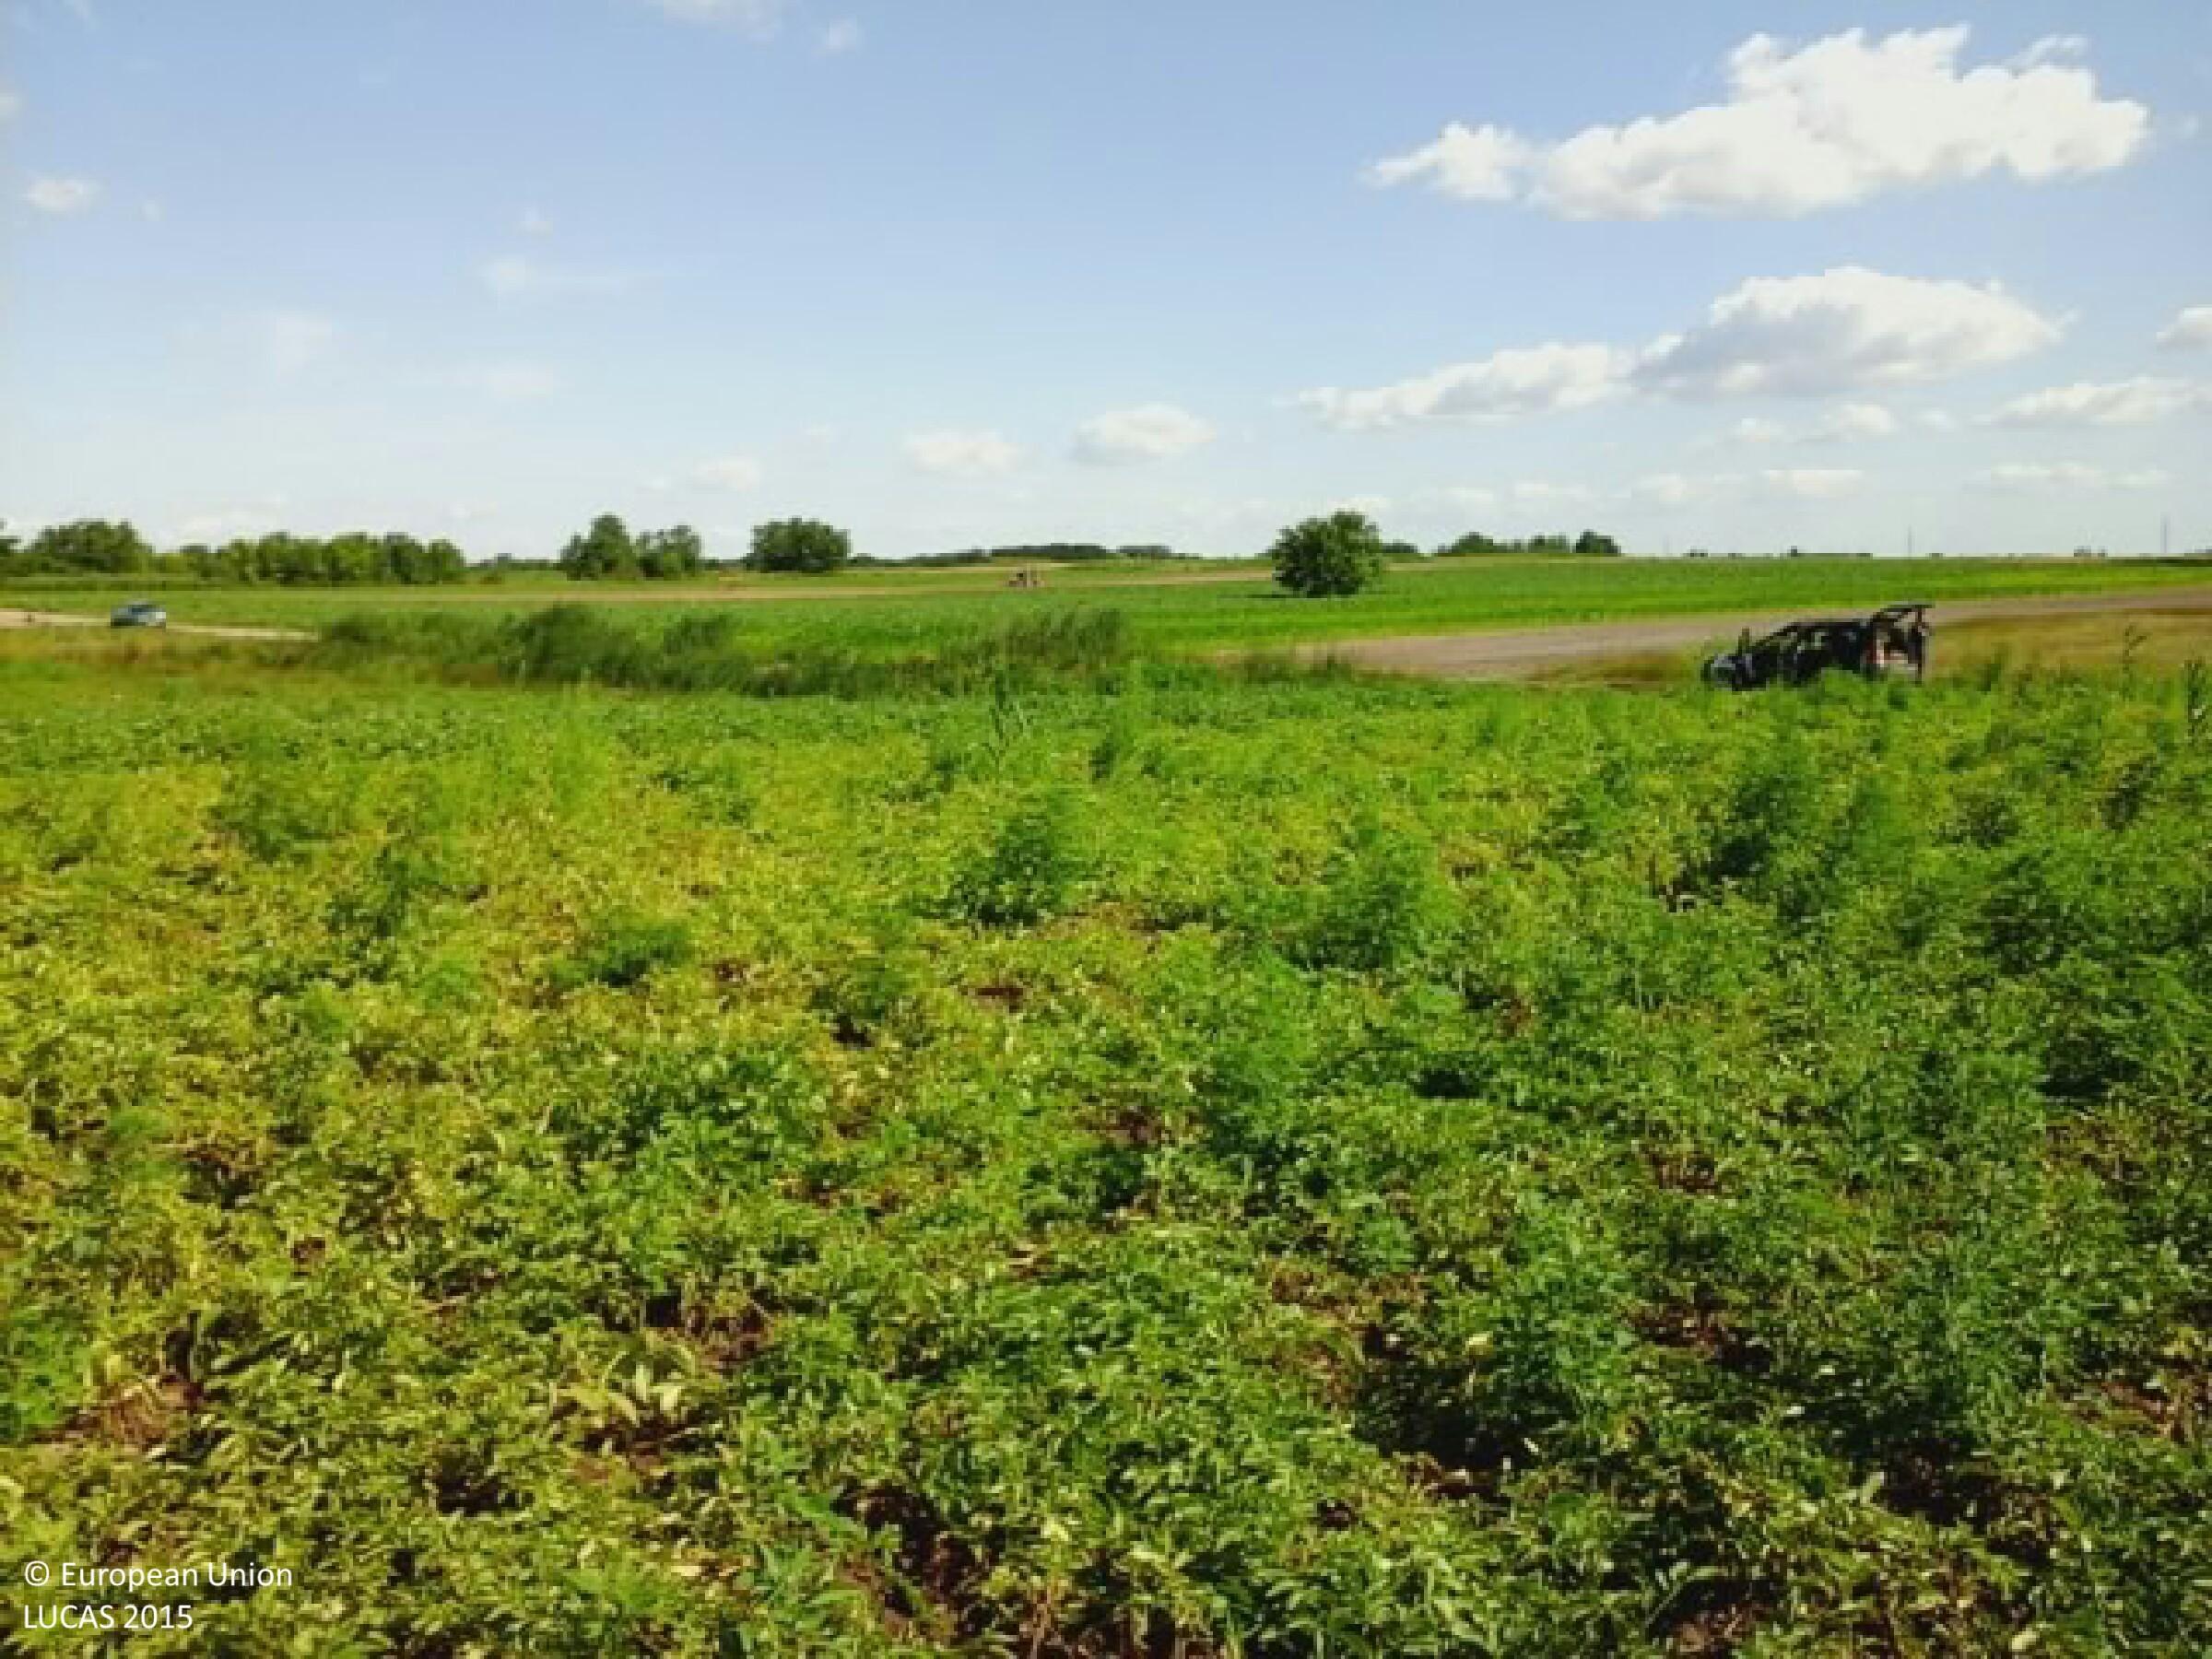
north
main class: Cropland
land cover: Potatoes
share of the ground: 50 - 75 %
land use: Agriculture (excluding fallow land and kitchen gardens)
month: July
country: HU
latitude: 47.3141
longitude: 19.1857
